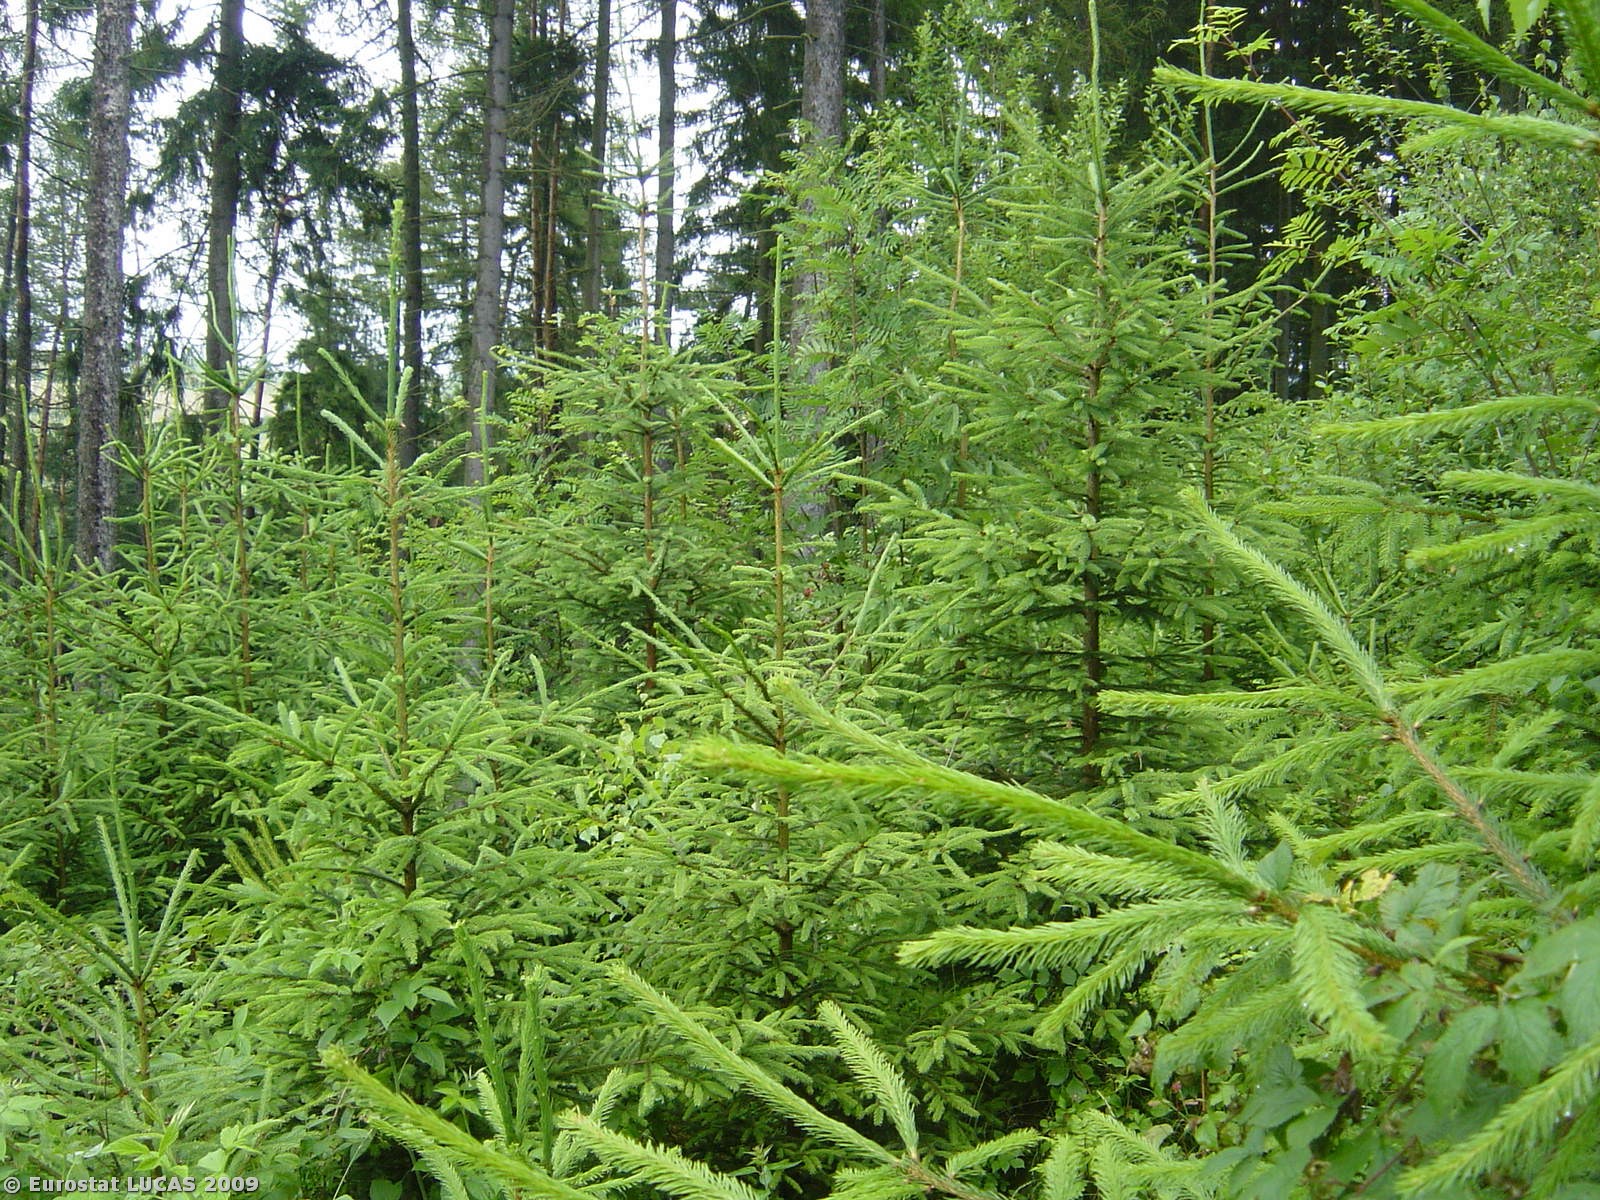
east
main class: Woodland
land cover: Mixed woodland
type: hemiboreal forest and nemoral coniferous forest and mixed broadleaved-coniferous forest
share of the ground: > 75 %
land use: Forestry
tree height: > 5 m
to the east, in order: Mixed woodland; Coniferous woodland; Broadleaved woodland; Dry stone walls; Grassland with sparse tree/shrub cover; Electric lines; Tracks; Broadleaved woodland; Grass margins; Artificial constructions; Railways
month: June
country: CZ
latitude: 49.6557
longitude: 16.5040
